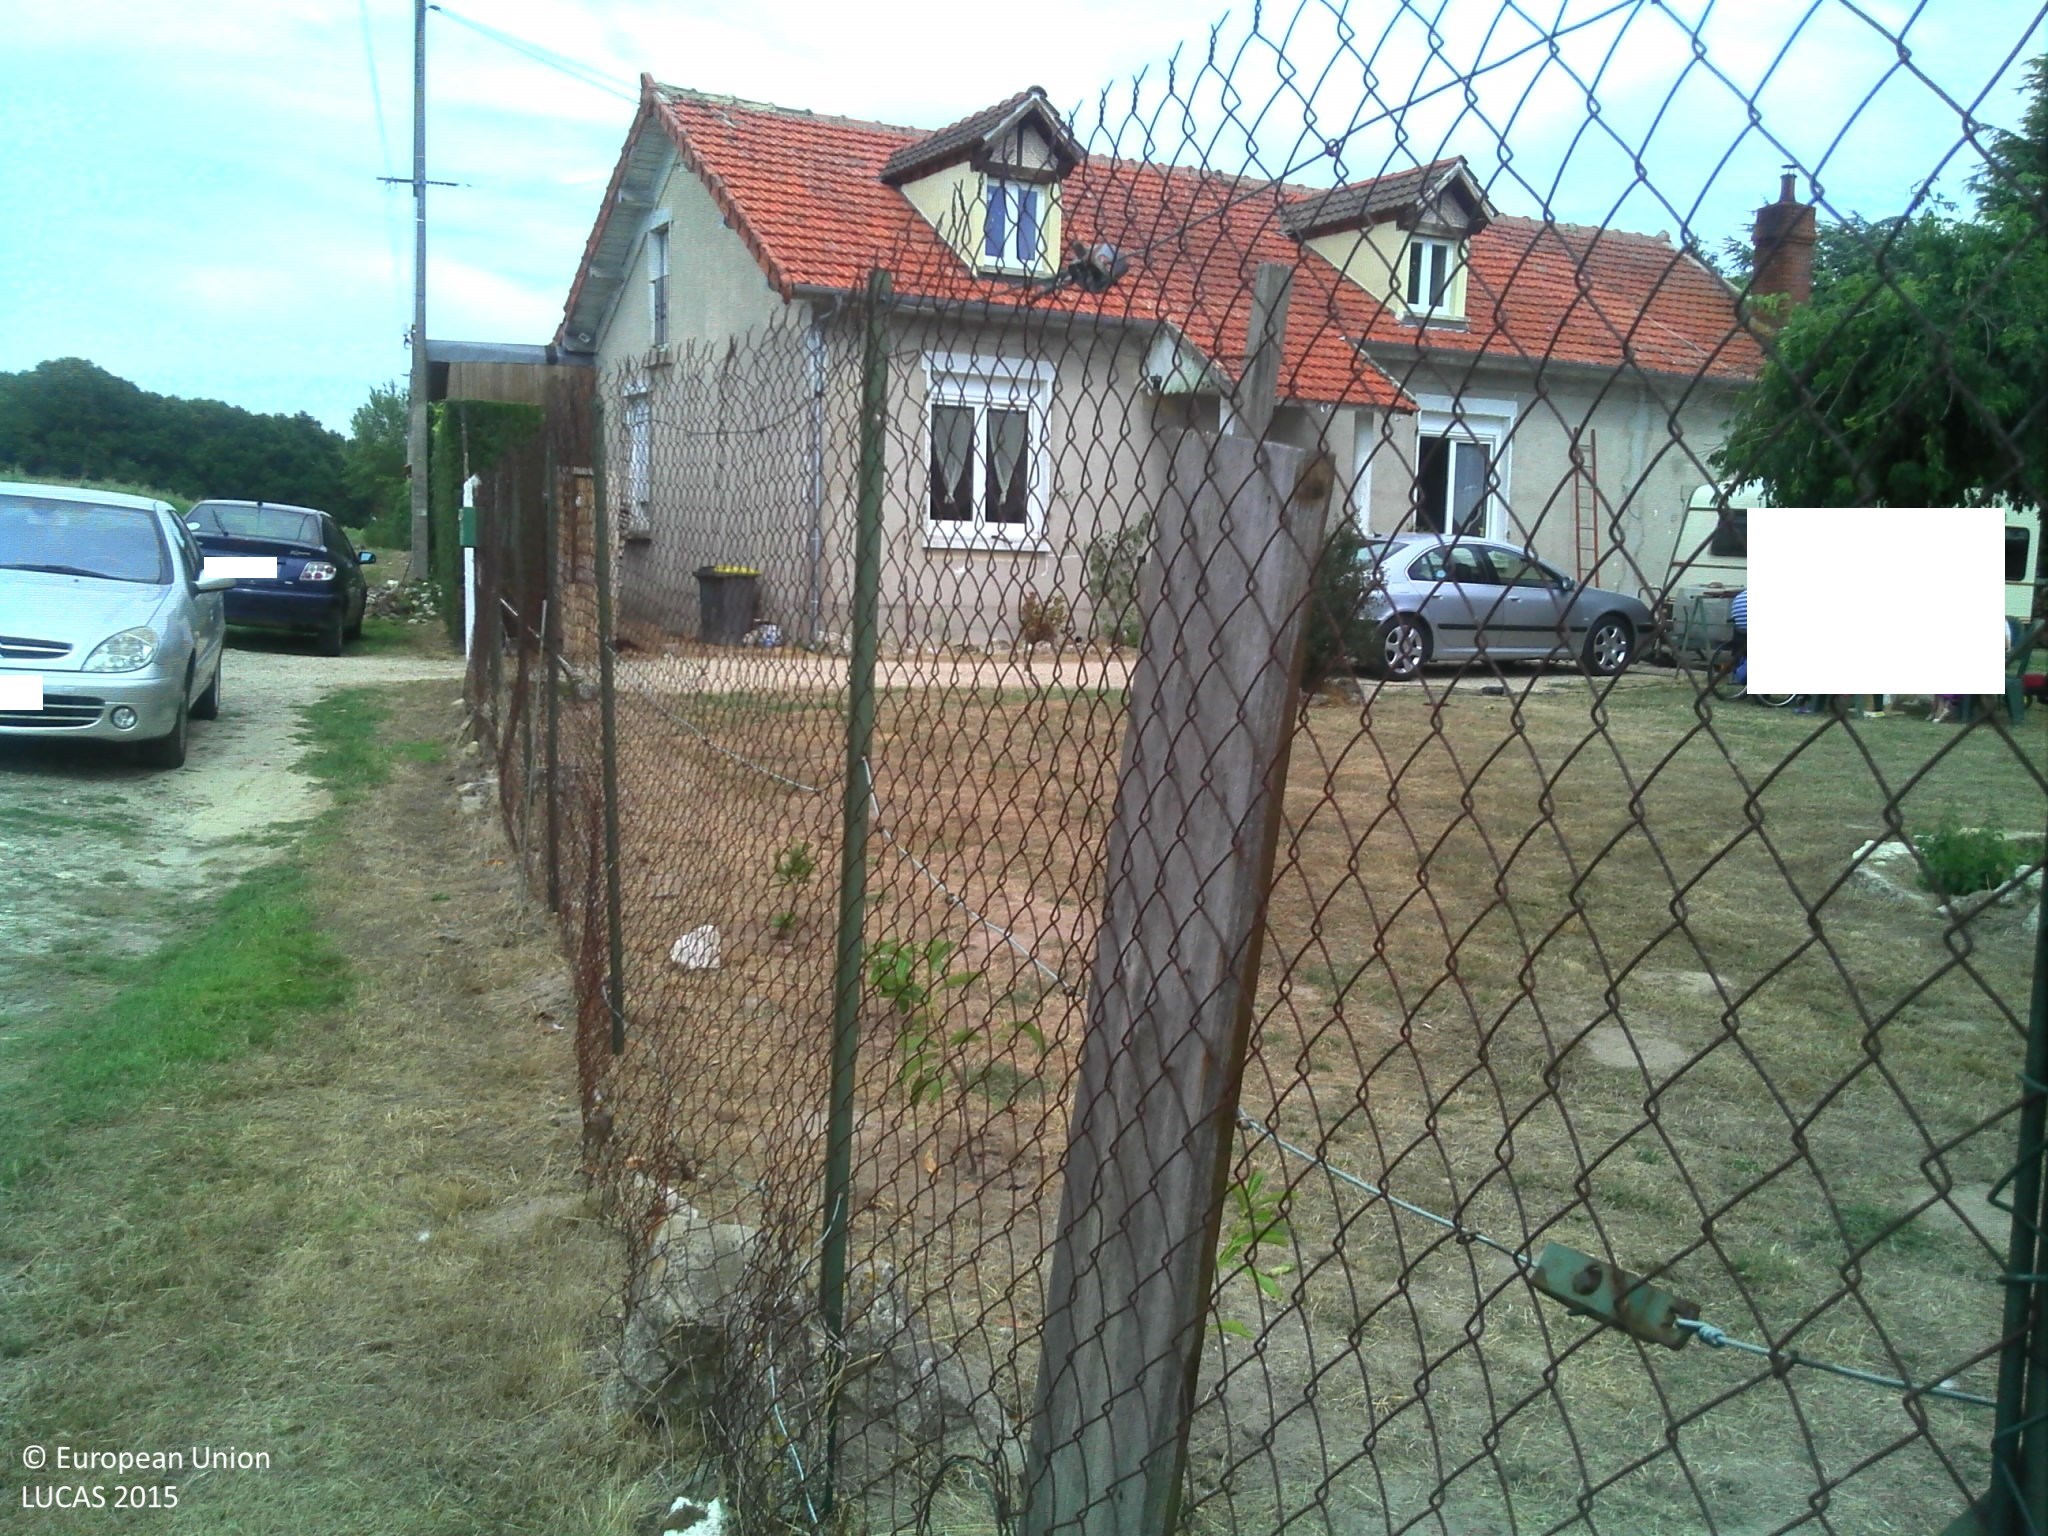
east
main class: Grassland
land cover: Grassland with sparse tree/shrub cover
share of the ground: > 75 %
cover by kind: herbaceous plants 95 %, broadleaved forest trees 5 %
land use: Residential
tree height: > 5 m
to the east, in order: Grassland with sparse tree/shrub cover; Artificial constructions in urban areas; Grassland with sparse tree/shrub cover
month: August
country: FR
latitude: 48.0434
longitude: 2.0334
